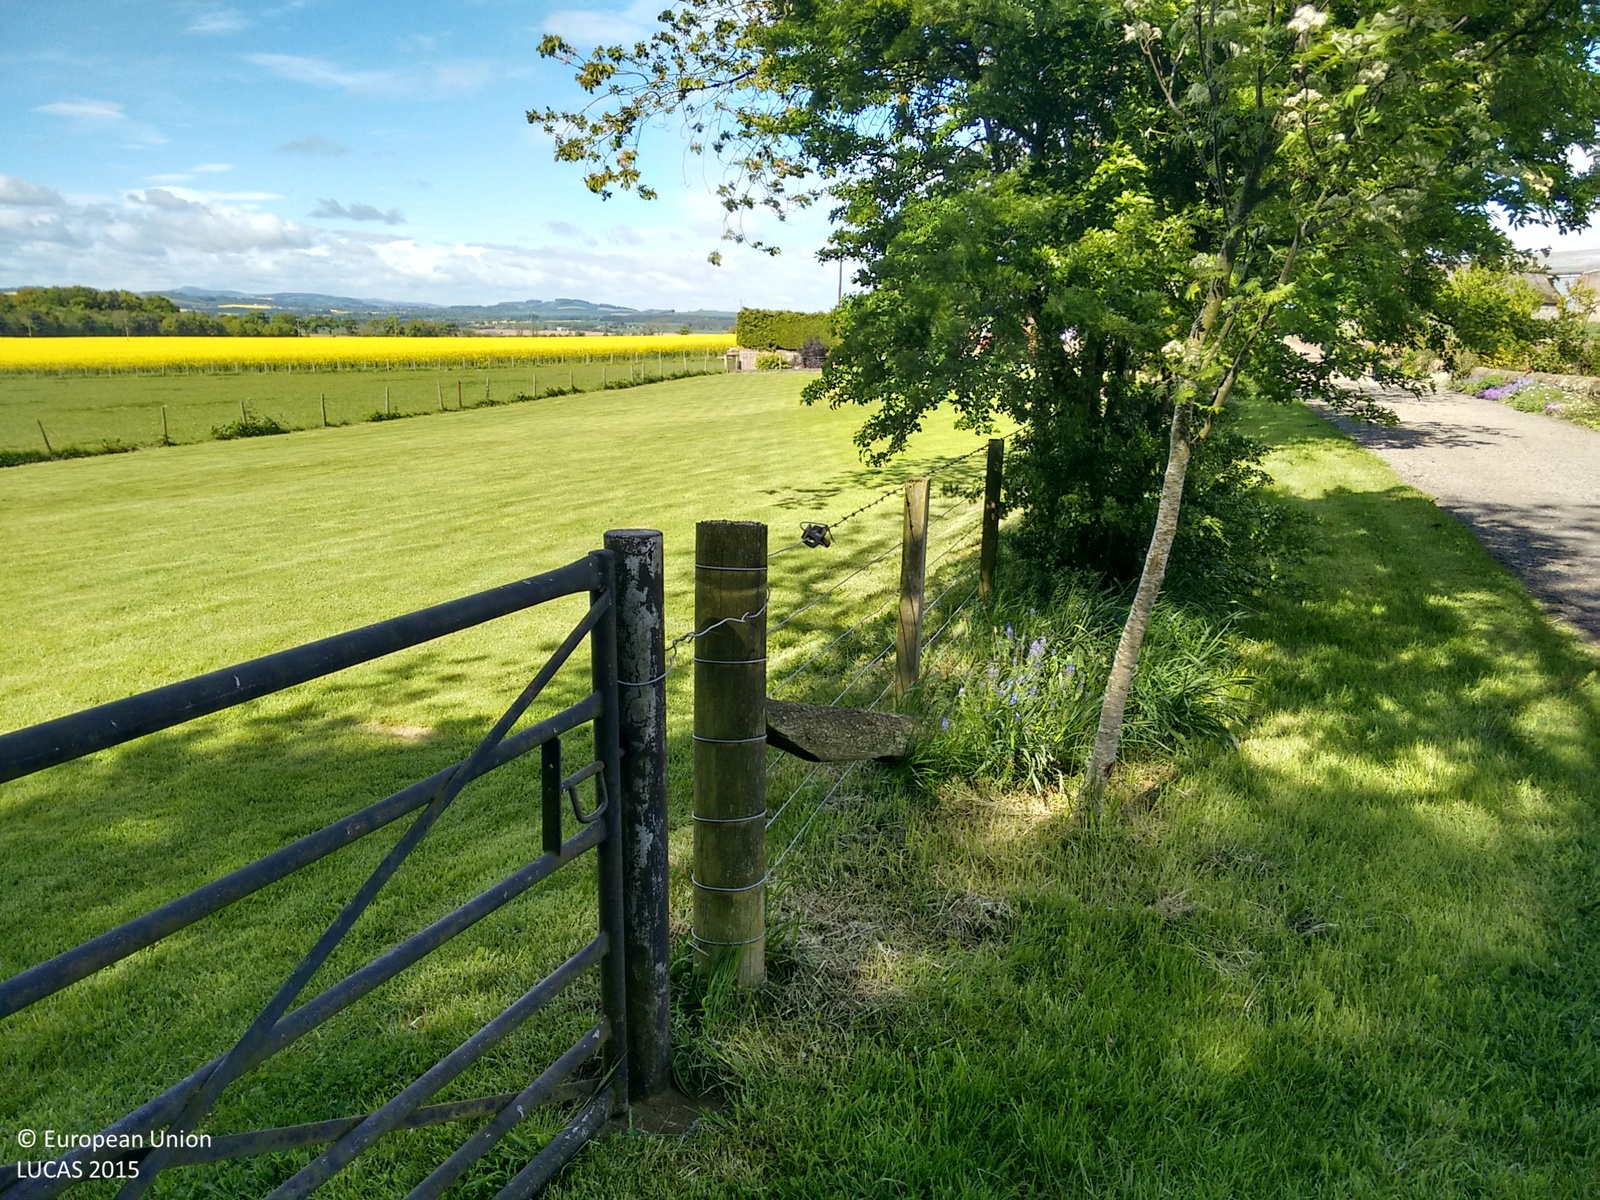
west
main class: Grassland
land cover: Grassland without tree/shrub cover
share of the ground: > 75 %
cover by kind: herbaceous plants 100 %
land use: Agriculture (excluding fallow land and kitchen gardens)
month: May
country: GB
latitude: 56.6568
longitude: -2.6028
